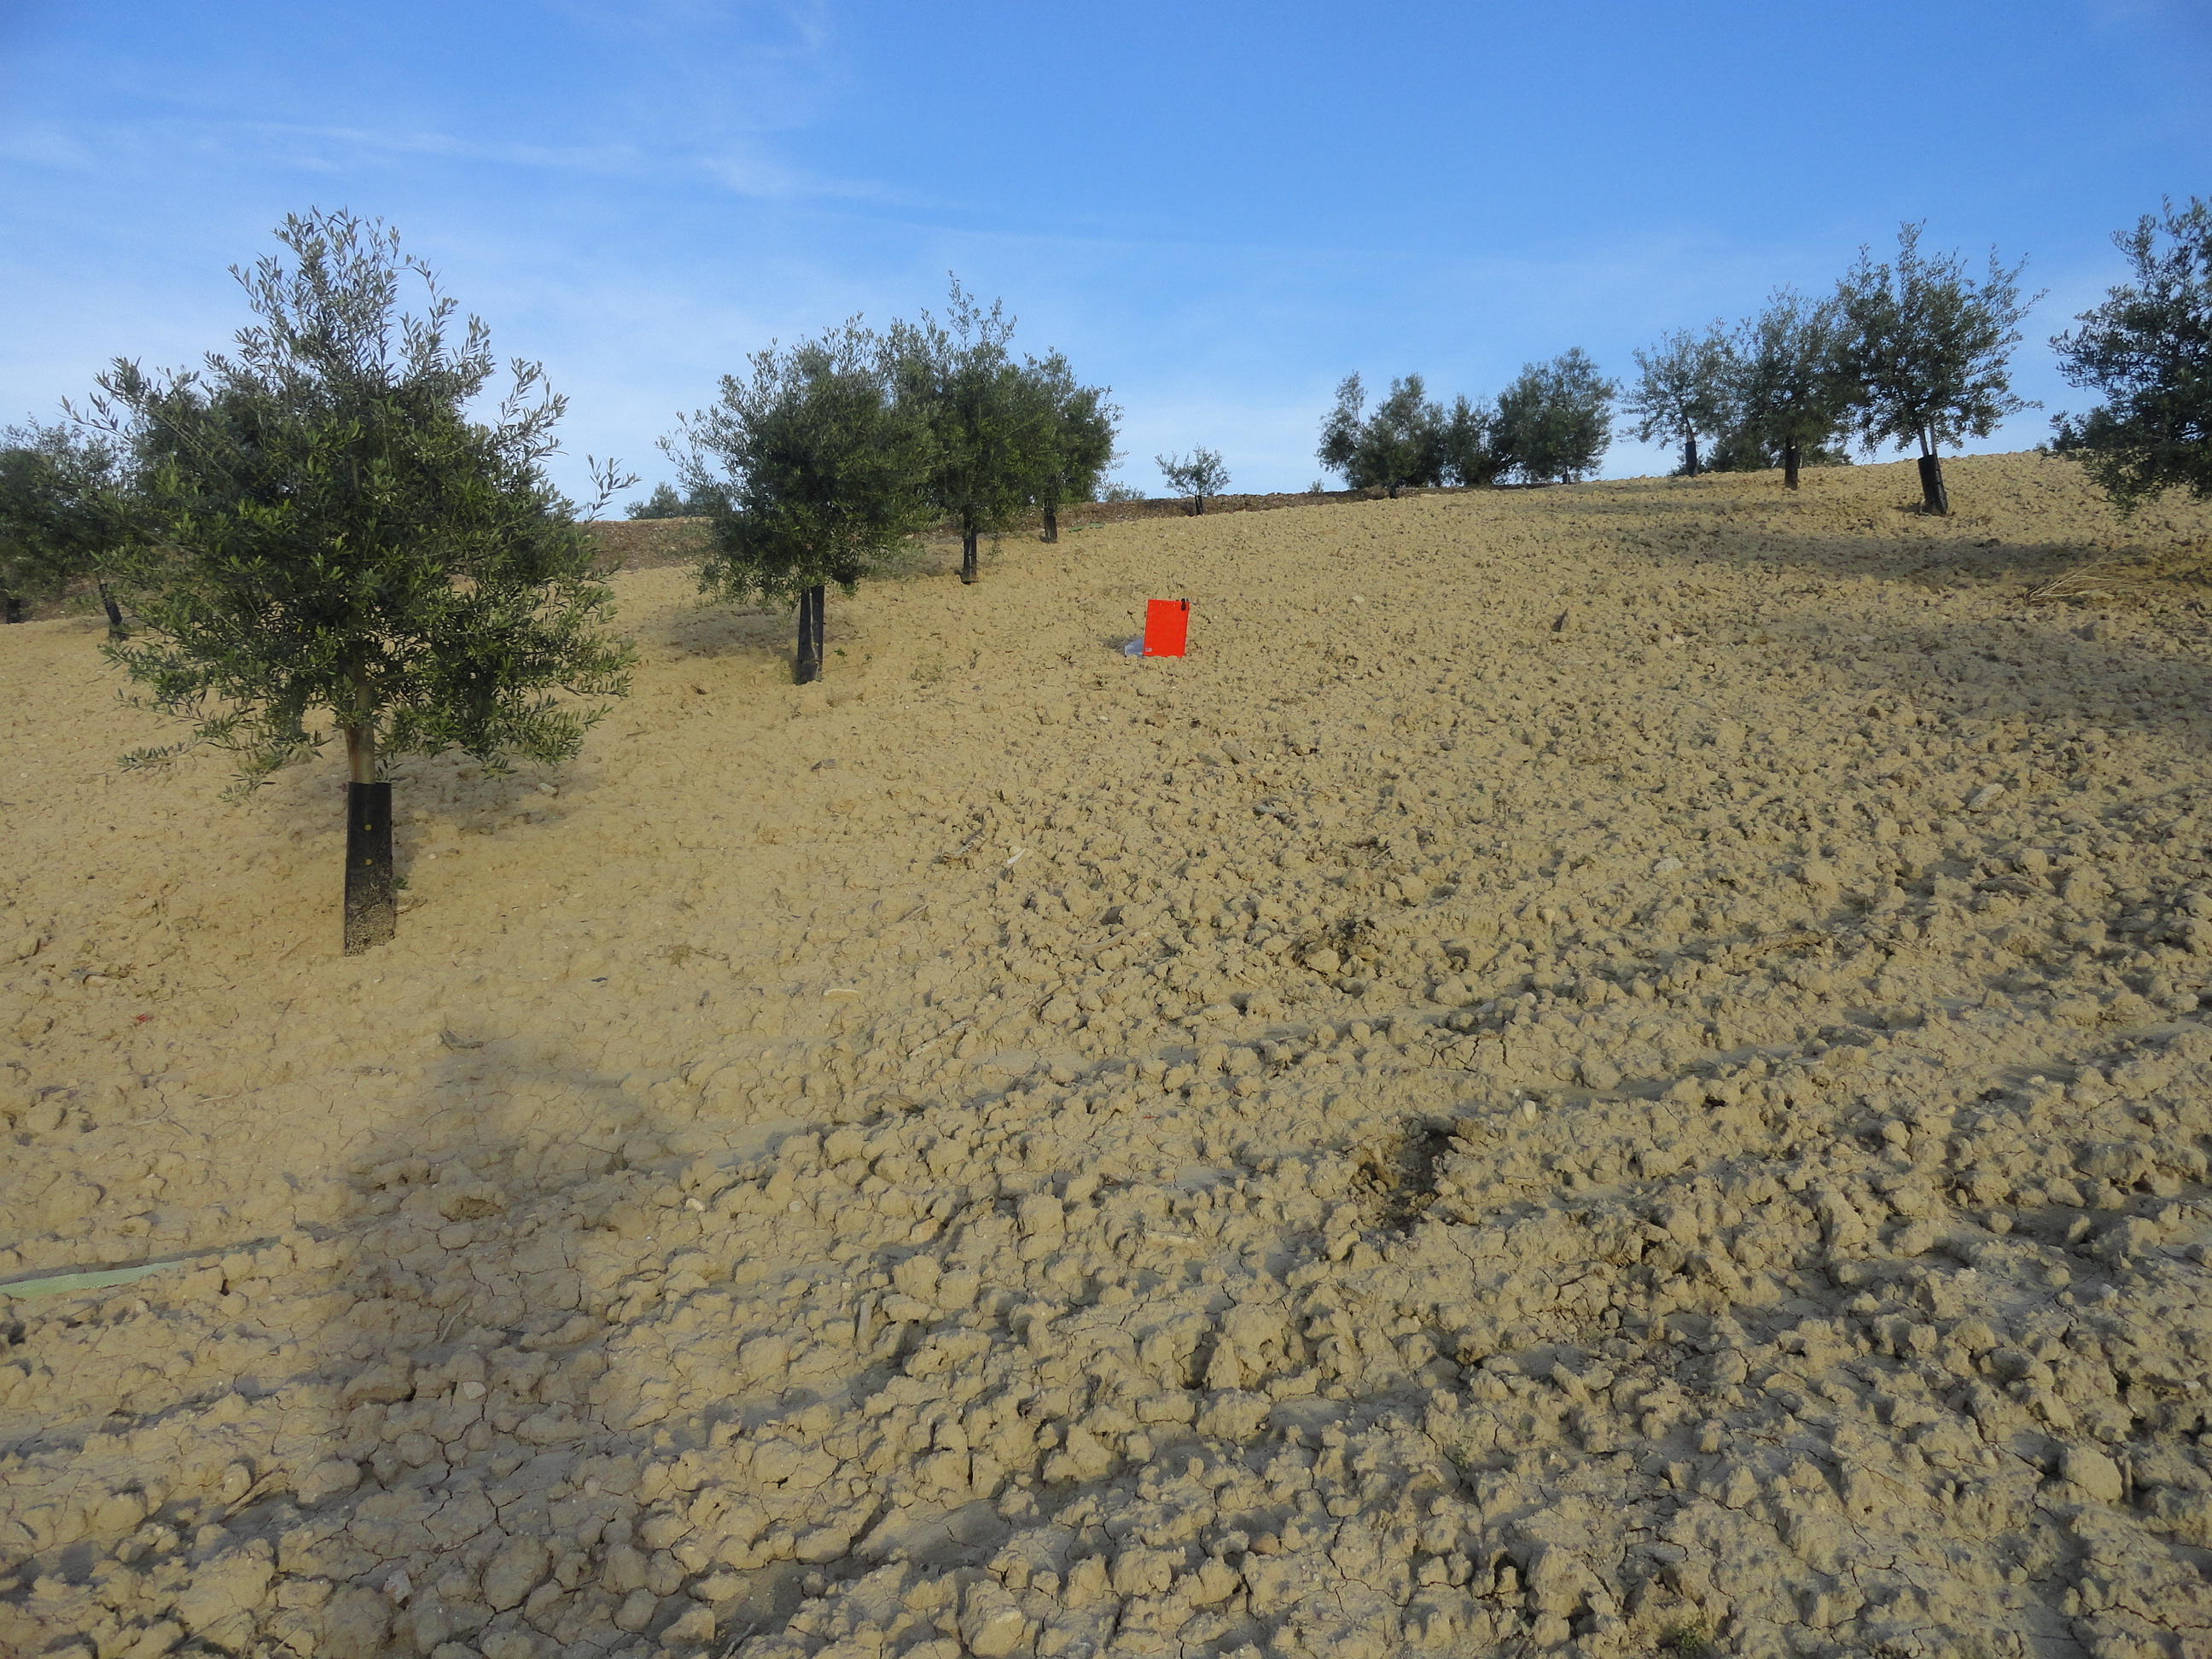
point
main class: Cropland
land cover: Olive groves
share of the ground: 10 - 25 %
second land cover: Other bare soil
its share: > 75 %
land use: Agriculture (excluding fallow land and kitchen gardens)
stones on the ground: < 10 %
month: April
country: ES
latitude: 37.6237
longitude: -4.6125
